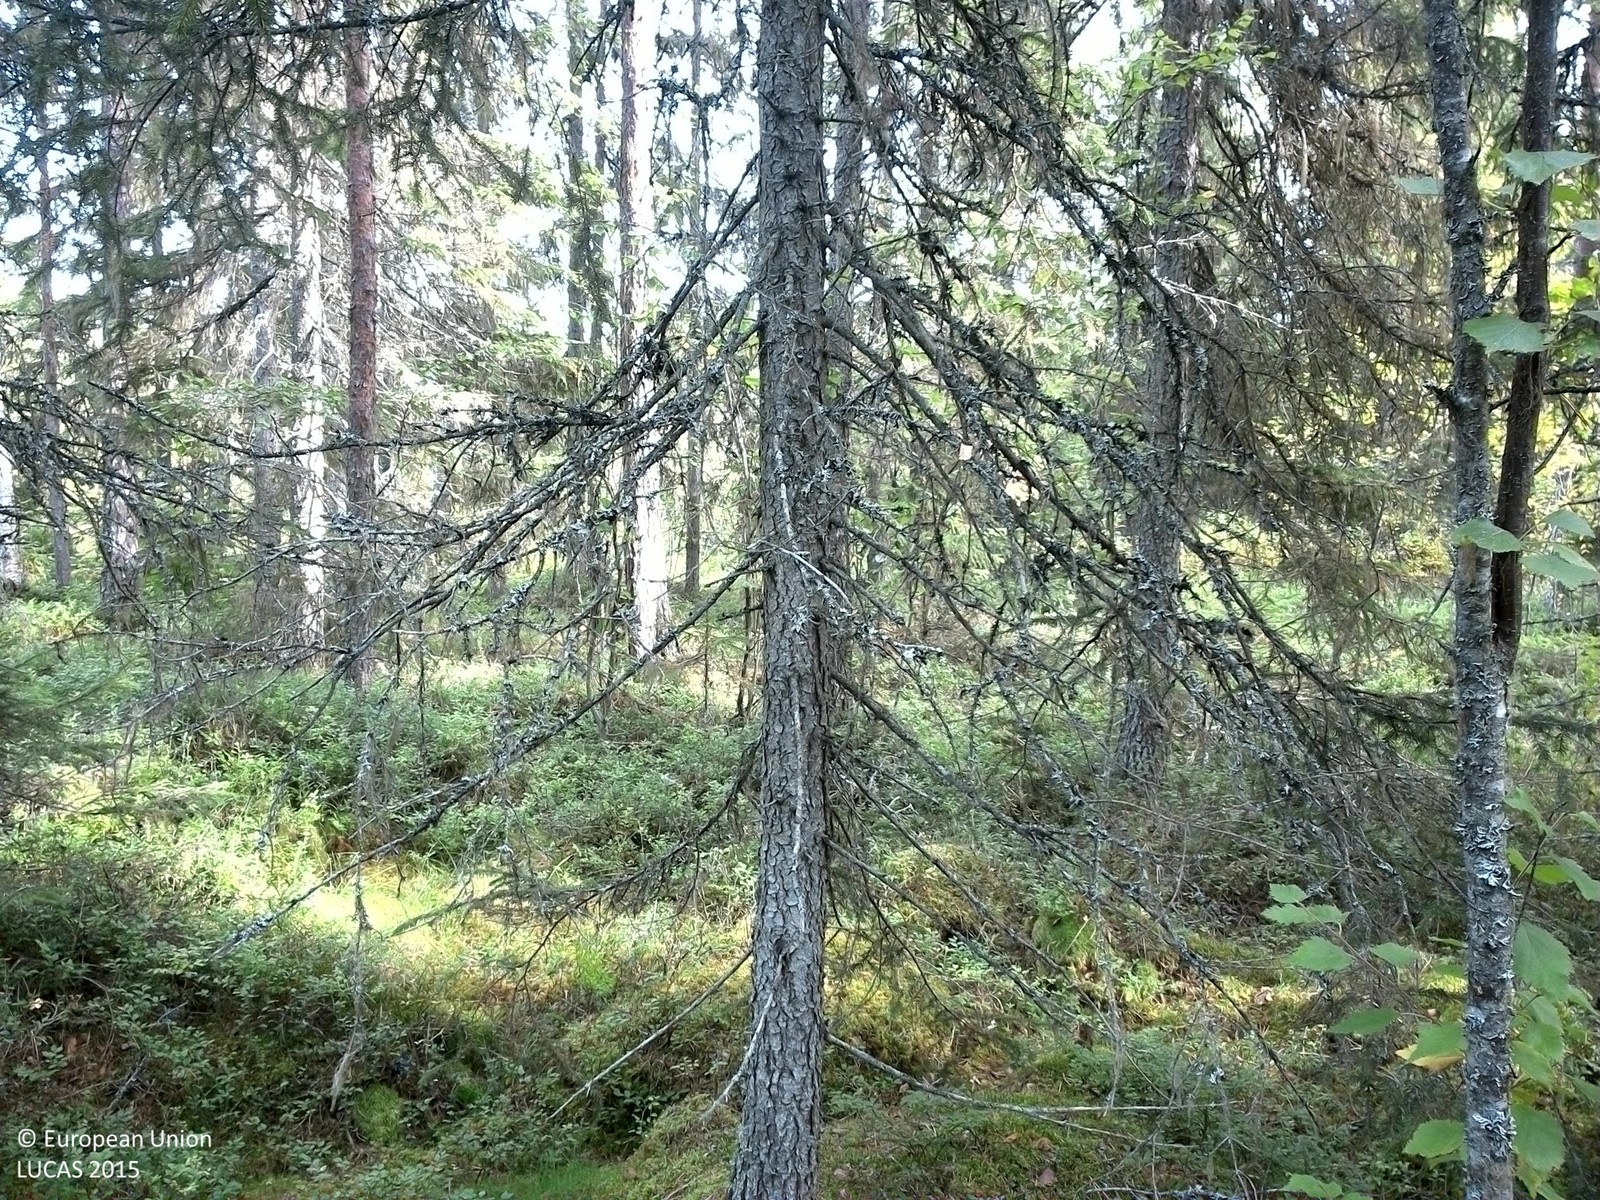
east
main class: Woodland
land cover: Spruce dominated coniferous woodland
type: boreal forest
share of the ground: > 75 %
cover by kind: coniferous forest trees 55 %, shrubs 25 %, broadleaved forest trees 10 %, lichens and mosses 10 %
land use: Forestry
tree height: > 5 m
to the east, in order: Spruce dominated coniferous woodland; Spruce dominated mixed woodland; Paved roads, cycling and walking lanes; Ditches and canals; Pine dominated coniferous woodland; Pine dominated mixed woodland
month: September
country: SE
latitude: 64.0277
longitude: 16.5403
